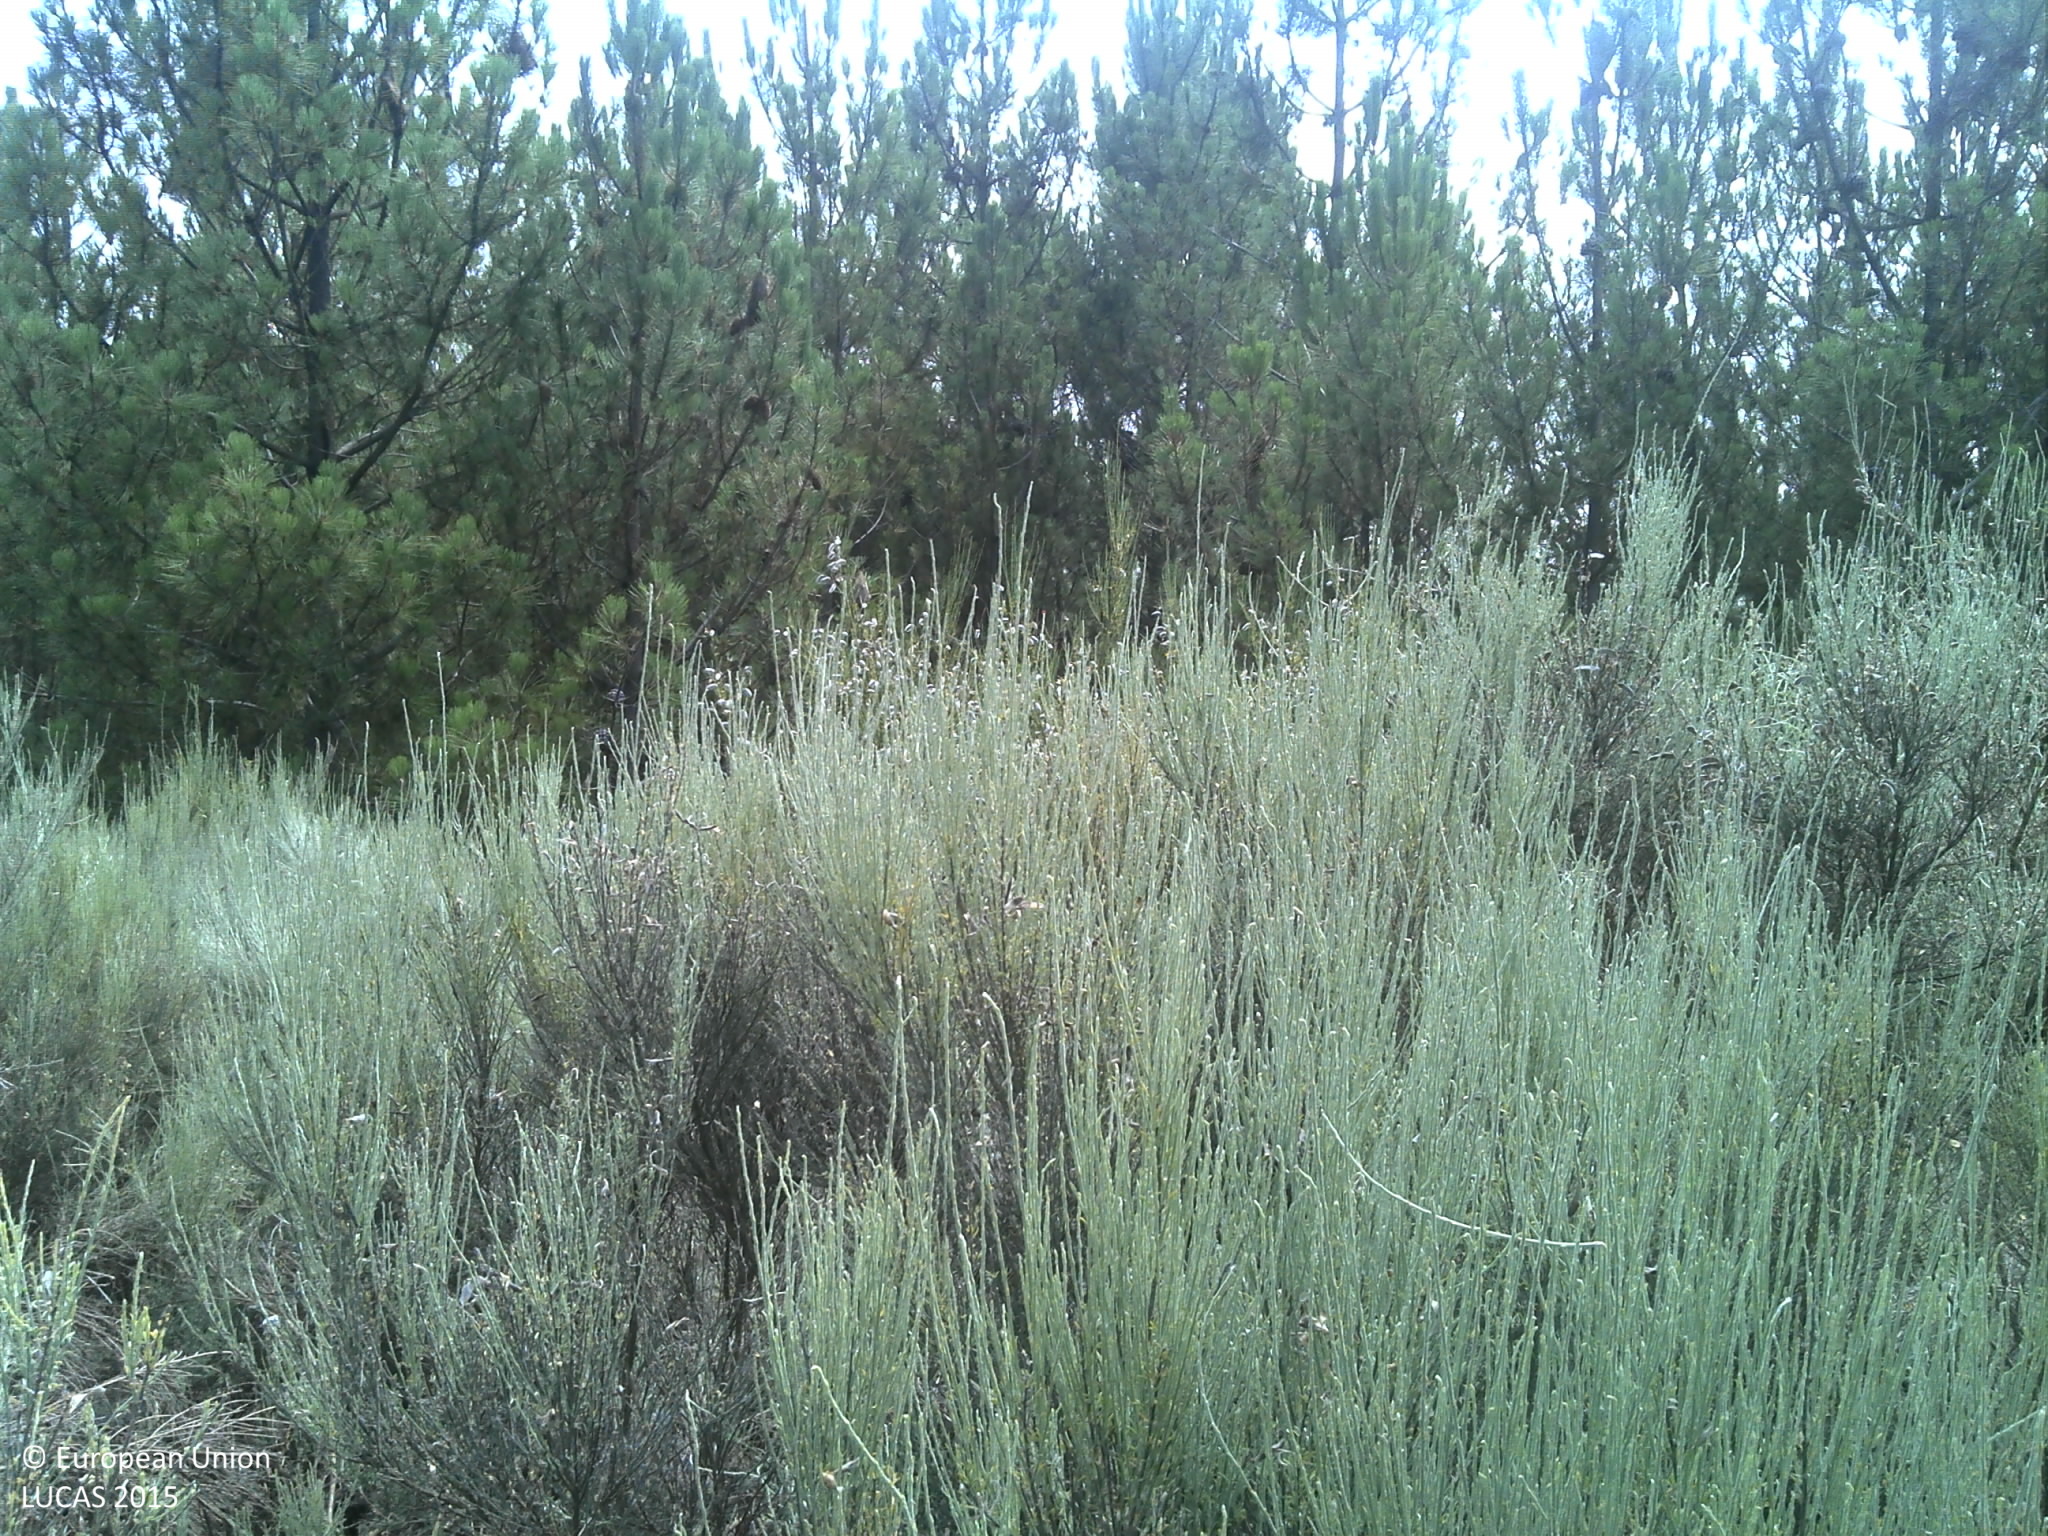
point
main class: Woodland
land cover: Pine dominated coniferous woodland
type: coniferous forest of the mediterranean region
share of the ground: 50 - 75 %
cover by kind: coniferous forest trees 50 %, shrubs 50 %
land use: Forestry
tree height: > 5 m
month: July
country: PT
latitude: 40.9405
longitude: -7.3492
